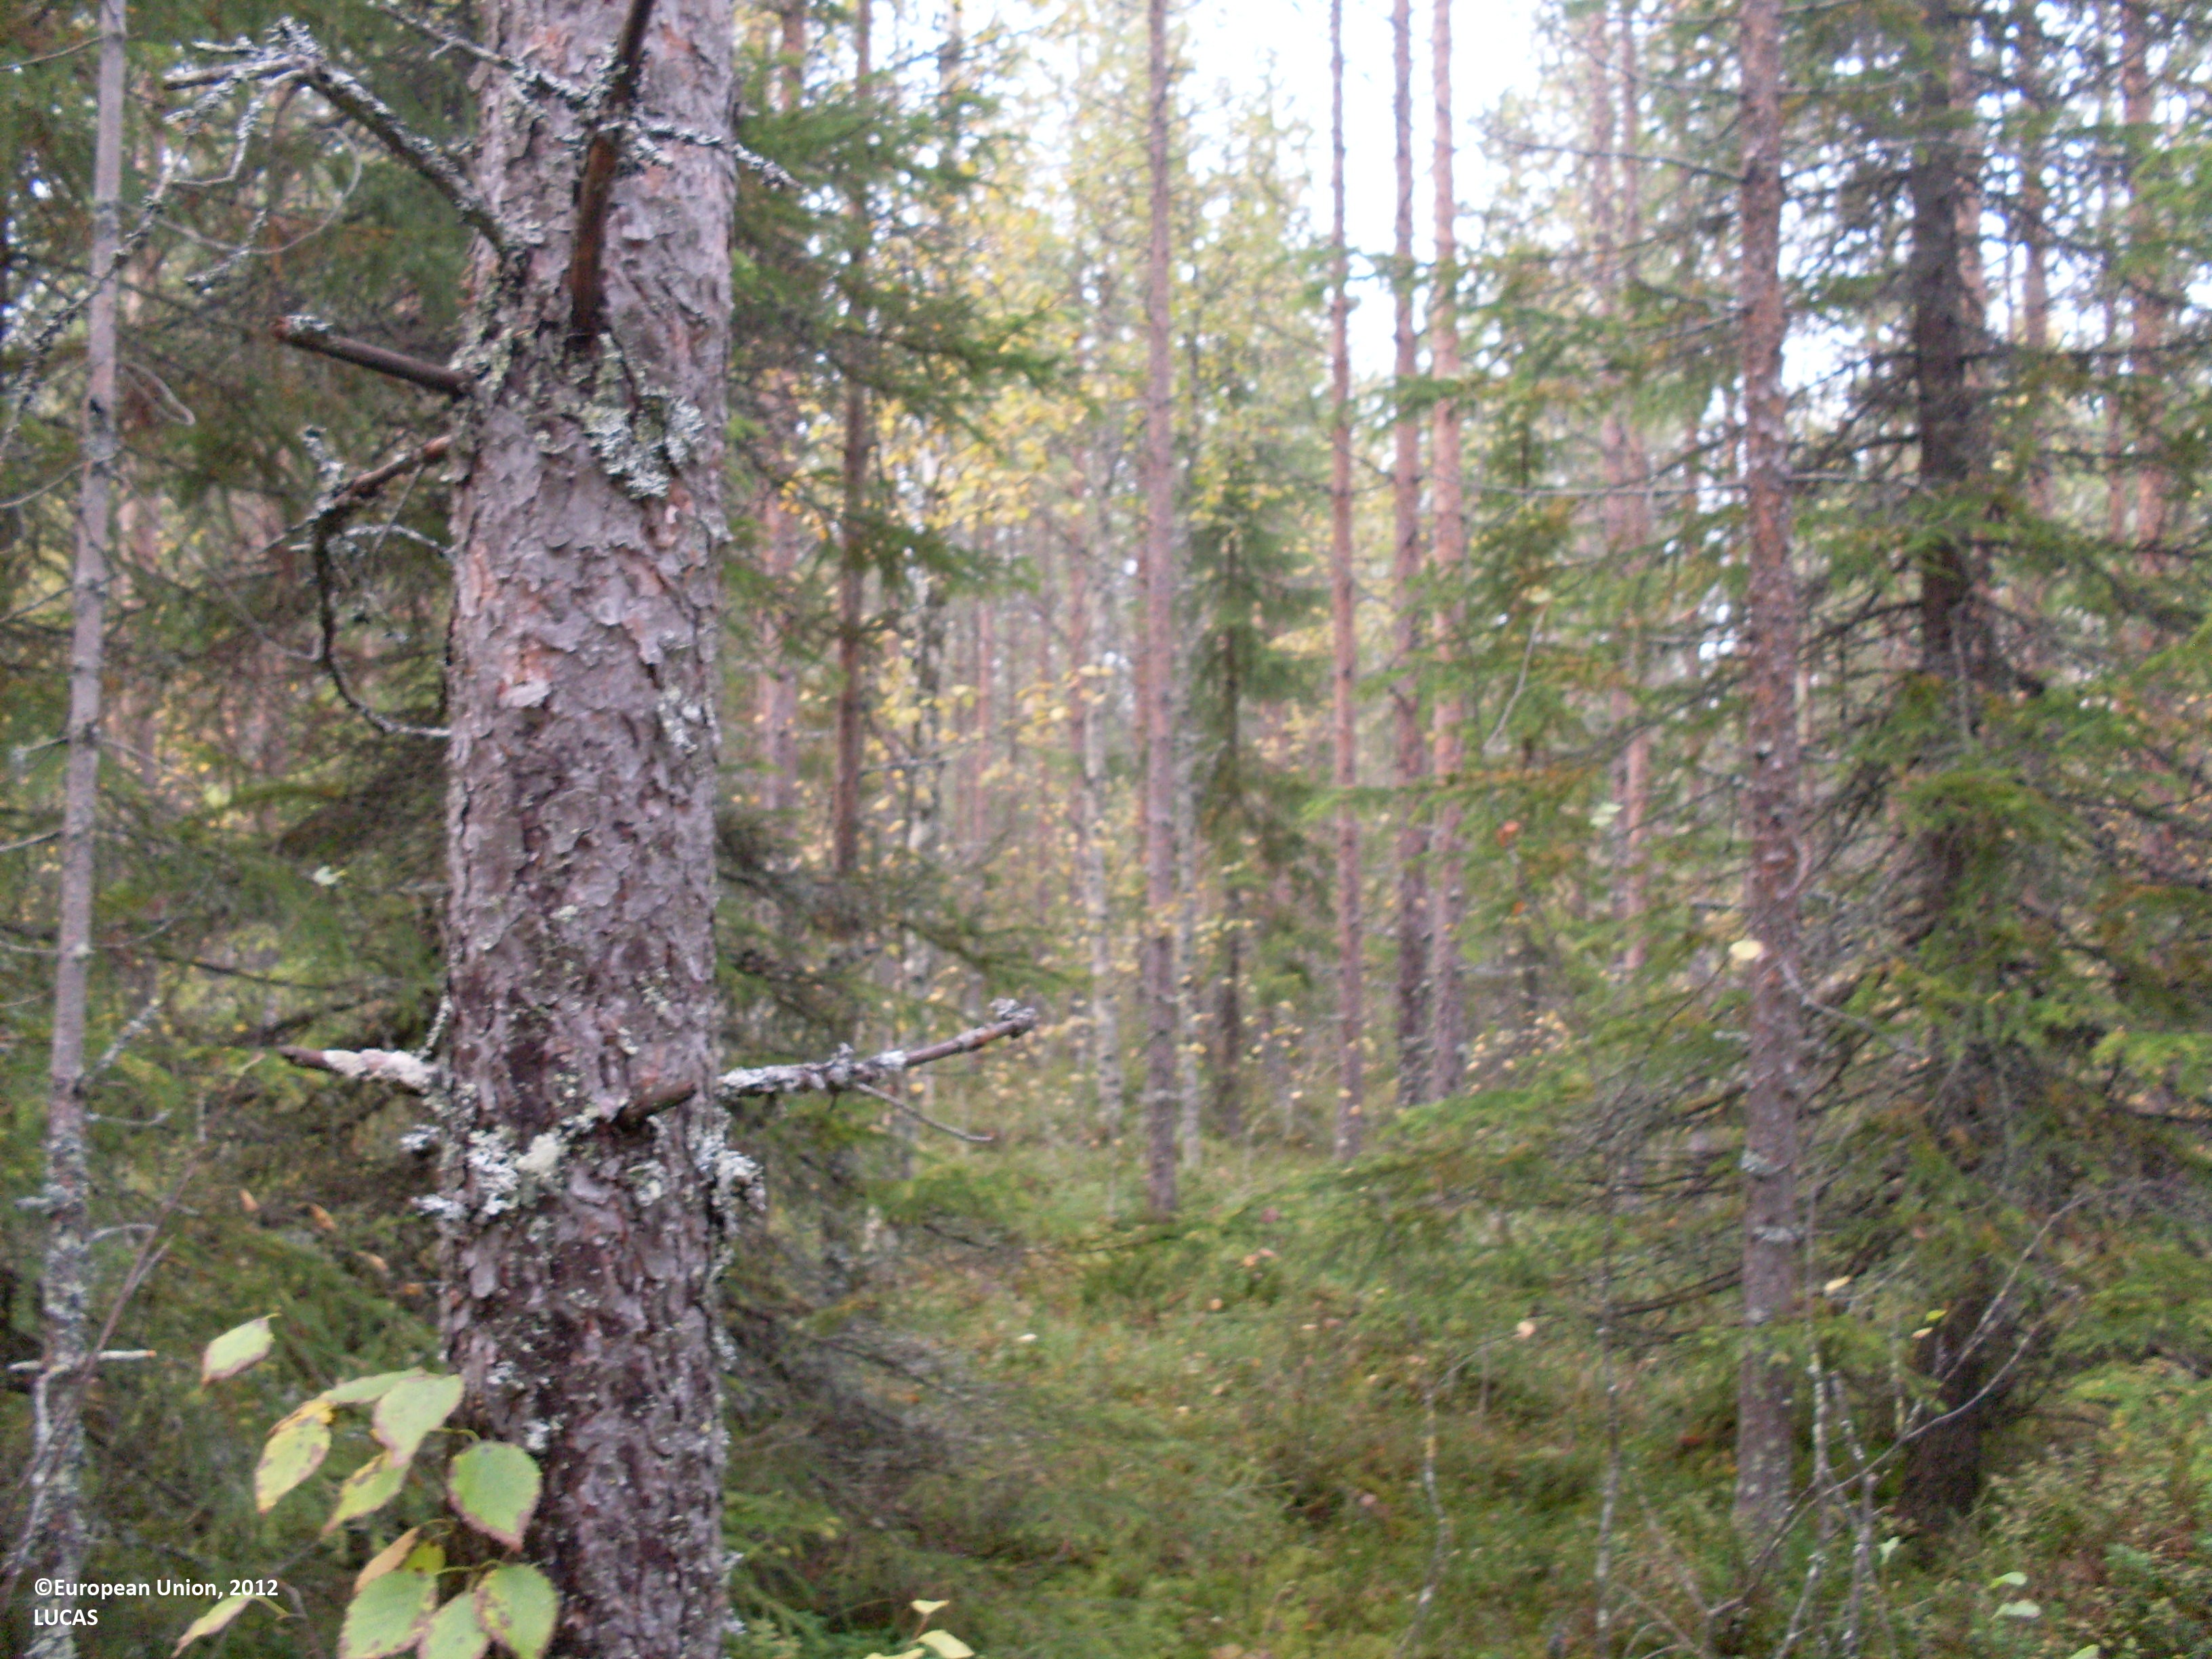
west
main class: Woodland
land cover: Pine dominated coniferous woodland
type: boreal forest
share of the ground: > 75 %
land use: Forestry
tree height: > 5 m
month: September
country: FI
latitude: 64.2655
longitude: 30.2931
